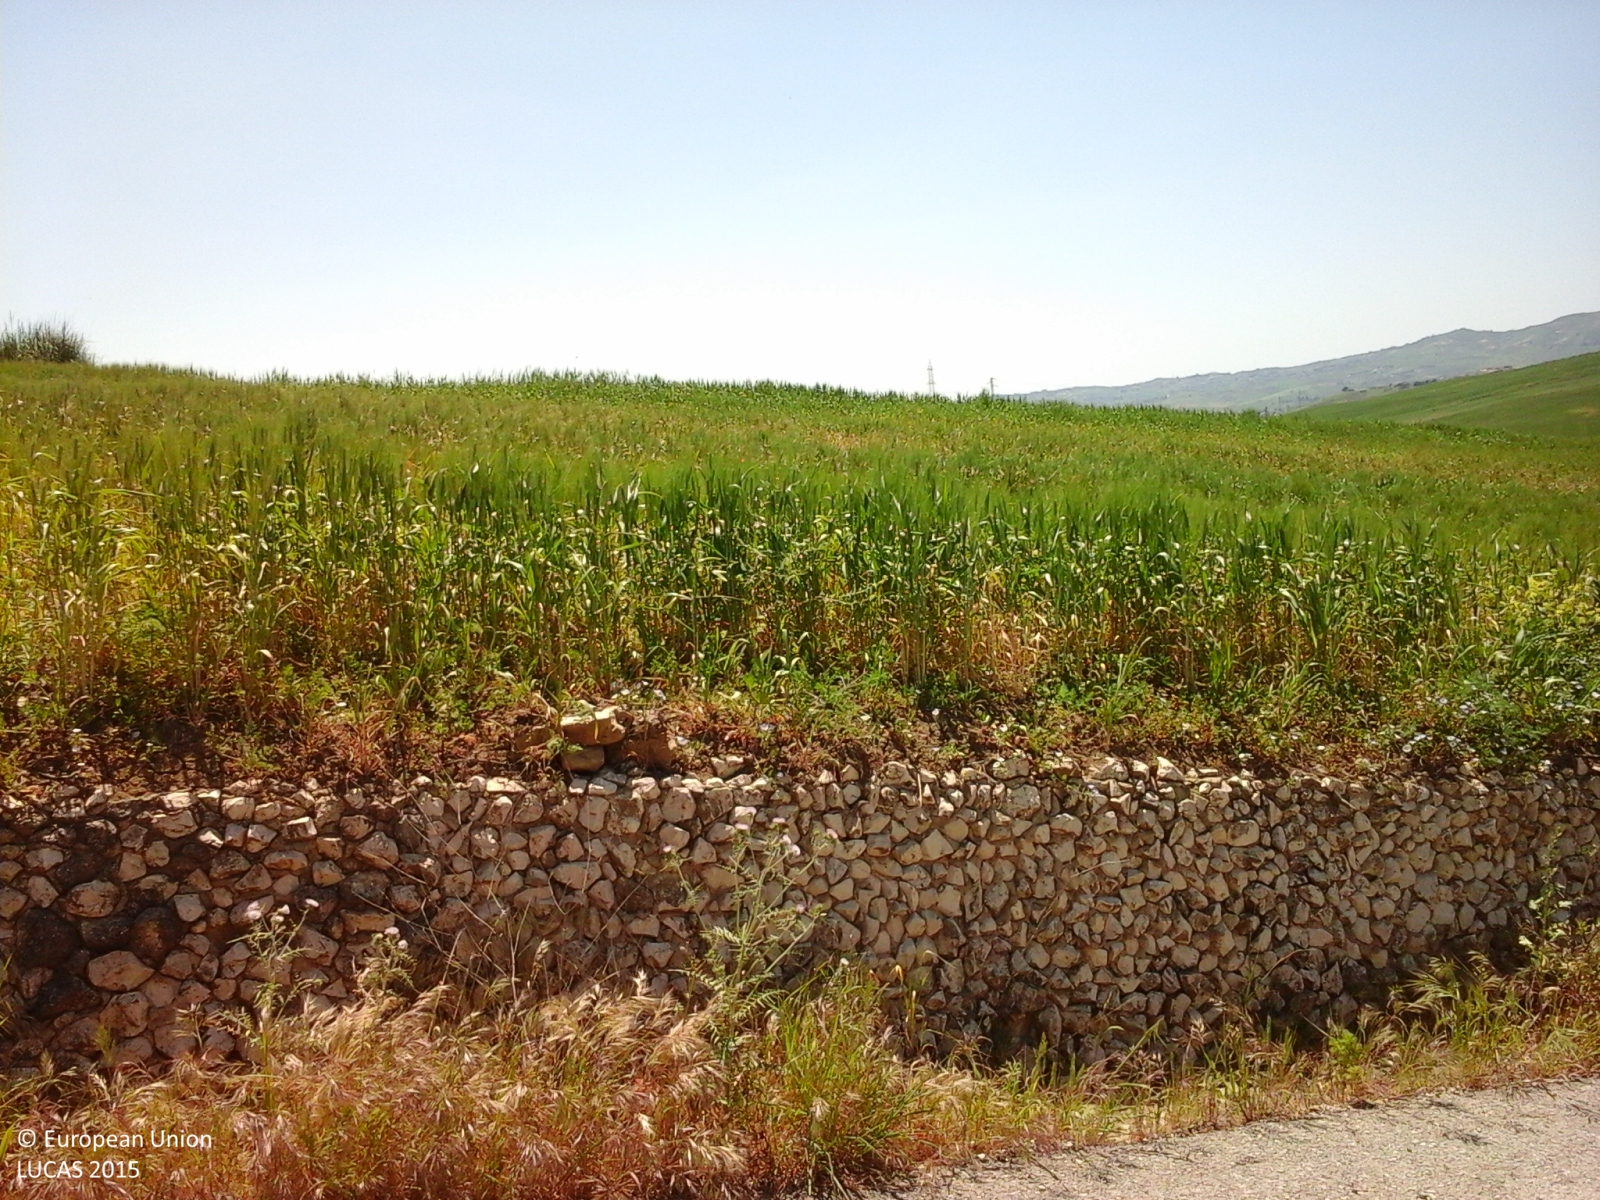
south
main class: Cropland
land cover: Durum wheat
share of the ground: > 75 %
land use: Agriculture (excluding fallow land and kitchen gardens)
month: April
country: IT
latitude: 37.4077
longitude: 13.5764
